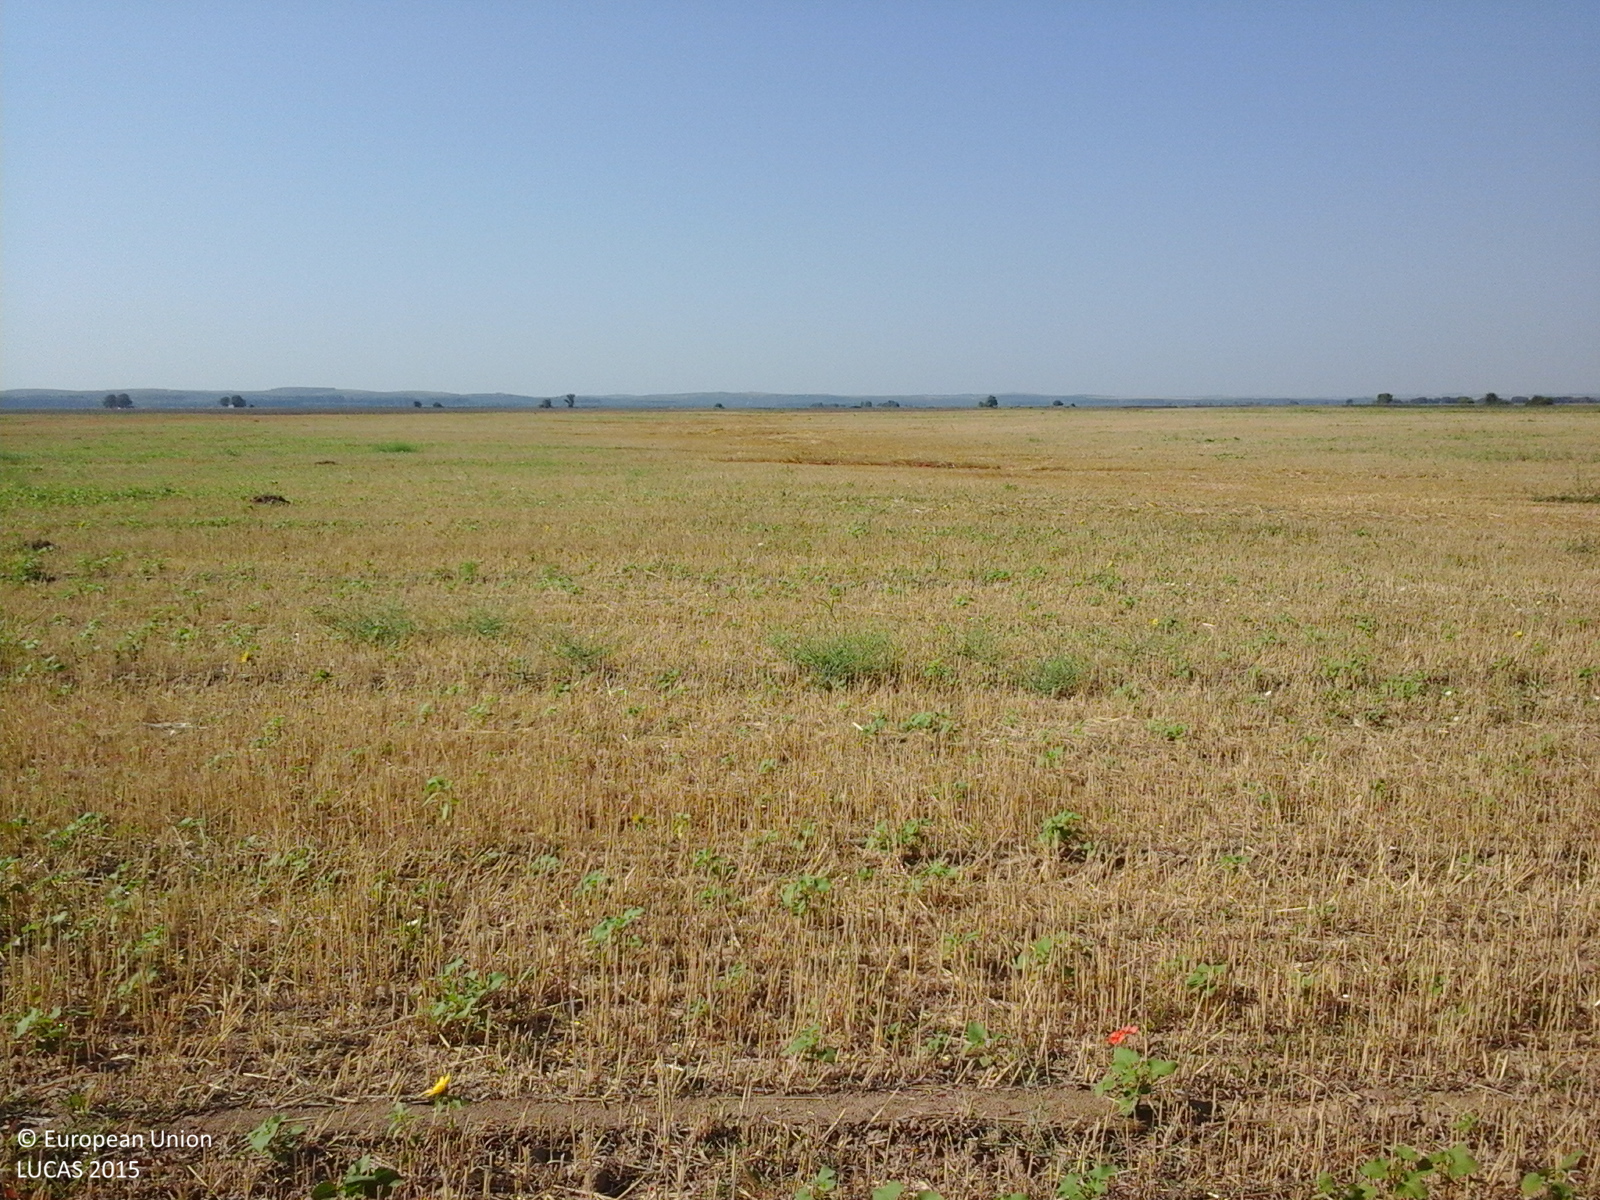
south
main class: Cropland
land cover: Durum wheat
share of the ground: 25 - 50 %
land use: Agriculture (excluding fallow land and kitchen gardens)
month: July
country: RO
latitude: 44.3194
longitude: 27.9460
